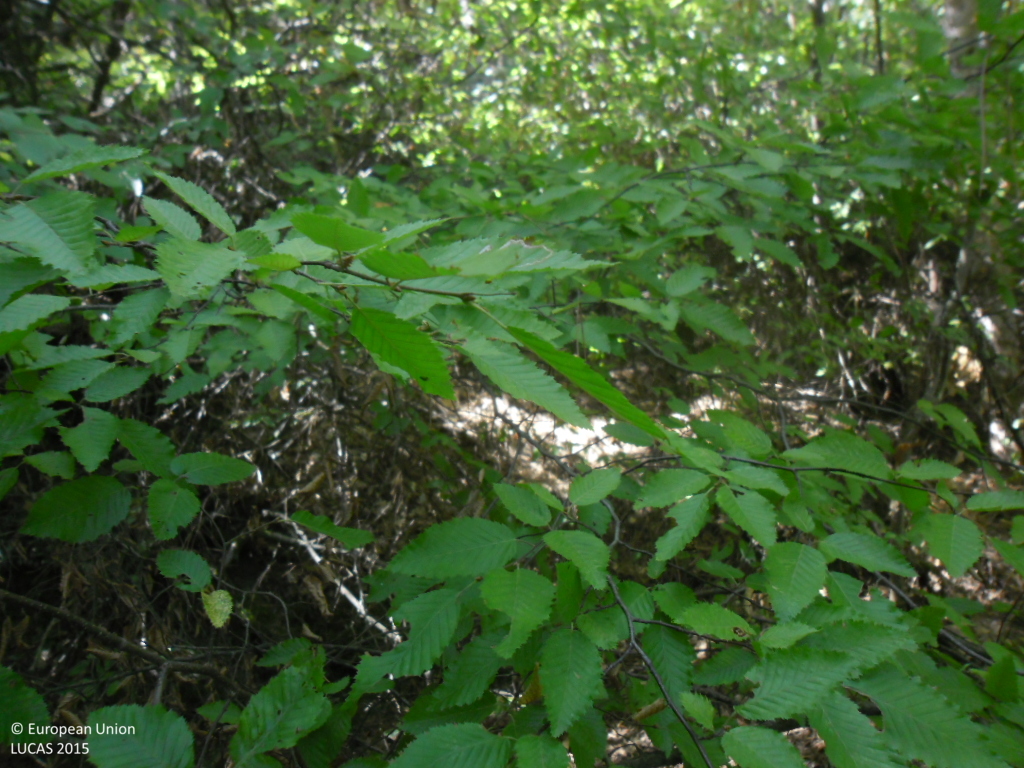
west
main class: Woodland
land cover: Other mixed woodland
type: hemiboreal forest and nemoral coniferous forest and mixed broadleaved-coniferous forest
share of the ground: > 75 %
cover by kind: coniferous forest trees 75 %, broadleaved forest trees 25 %
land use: Forestry
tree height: > 5 m
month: September
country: BG
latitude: 41.7422
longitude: 23.1162
